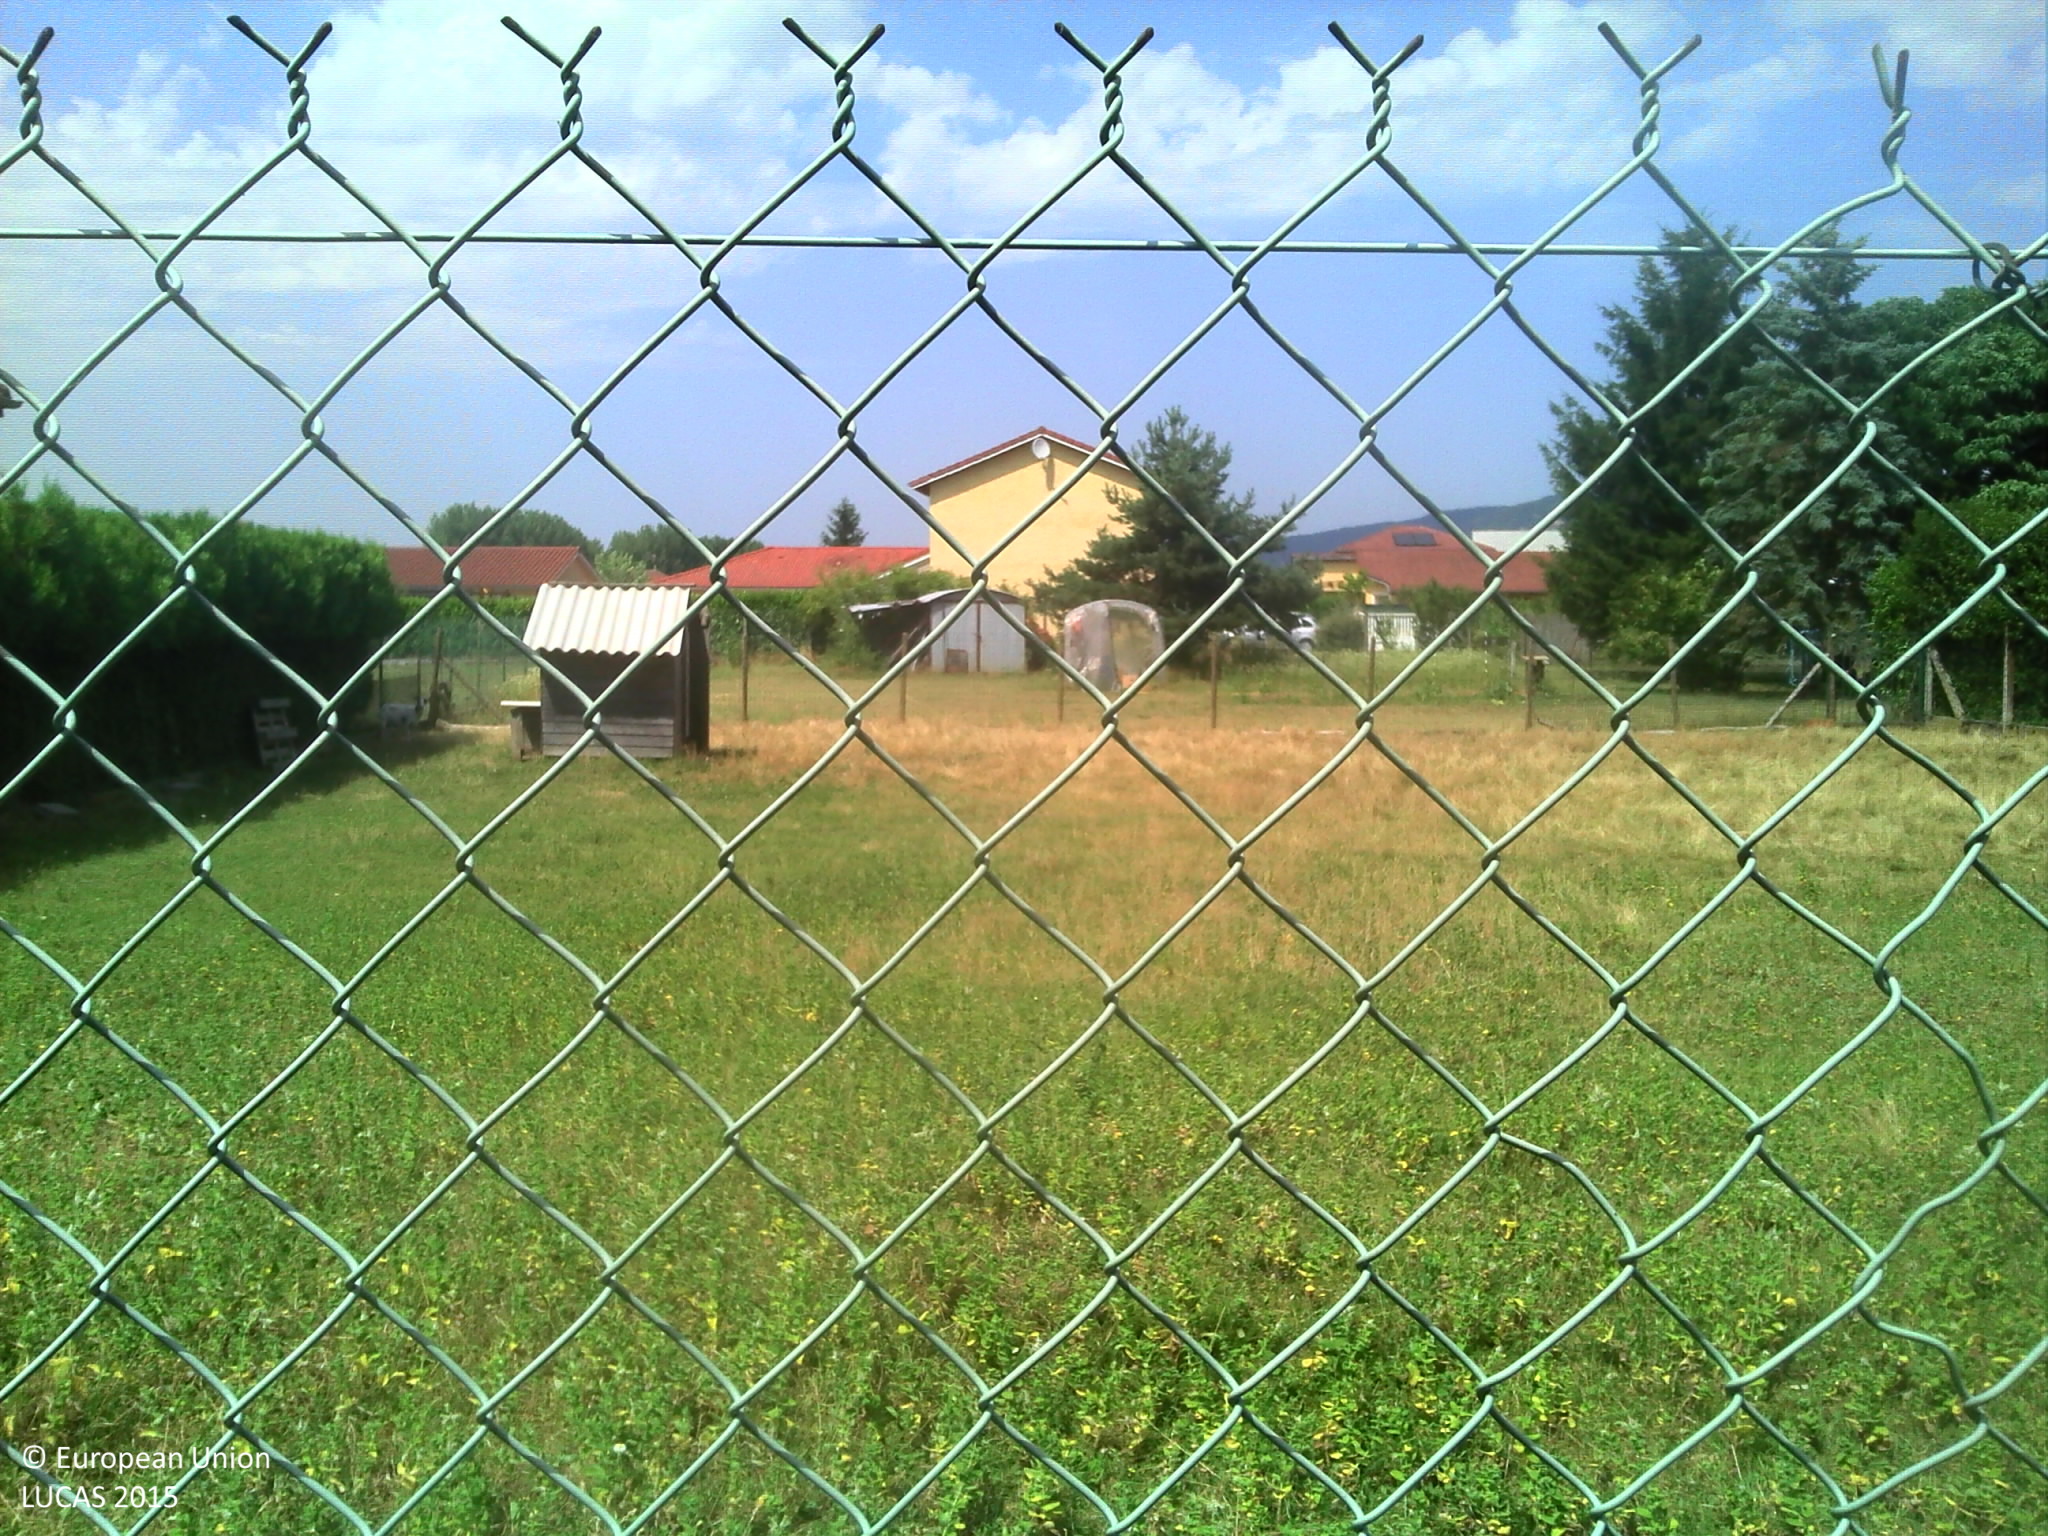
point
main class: Grassland
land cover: Grassland without tree/shrub cover
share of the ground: > 75 %
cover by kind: herbaceous plants 100 %
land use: Residential
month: July
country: FR
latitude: 45.8523
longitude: 5.3290
